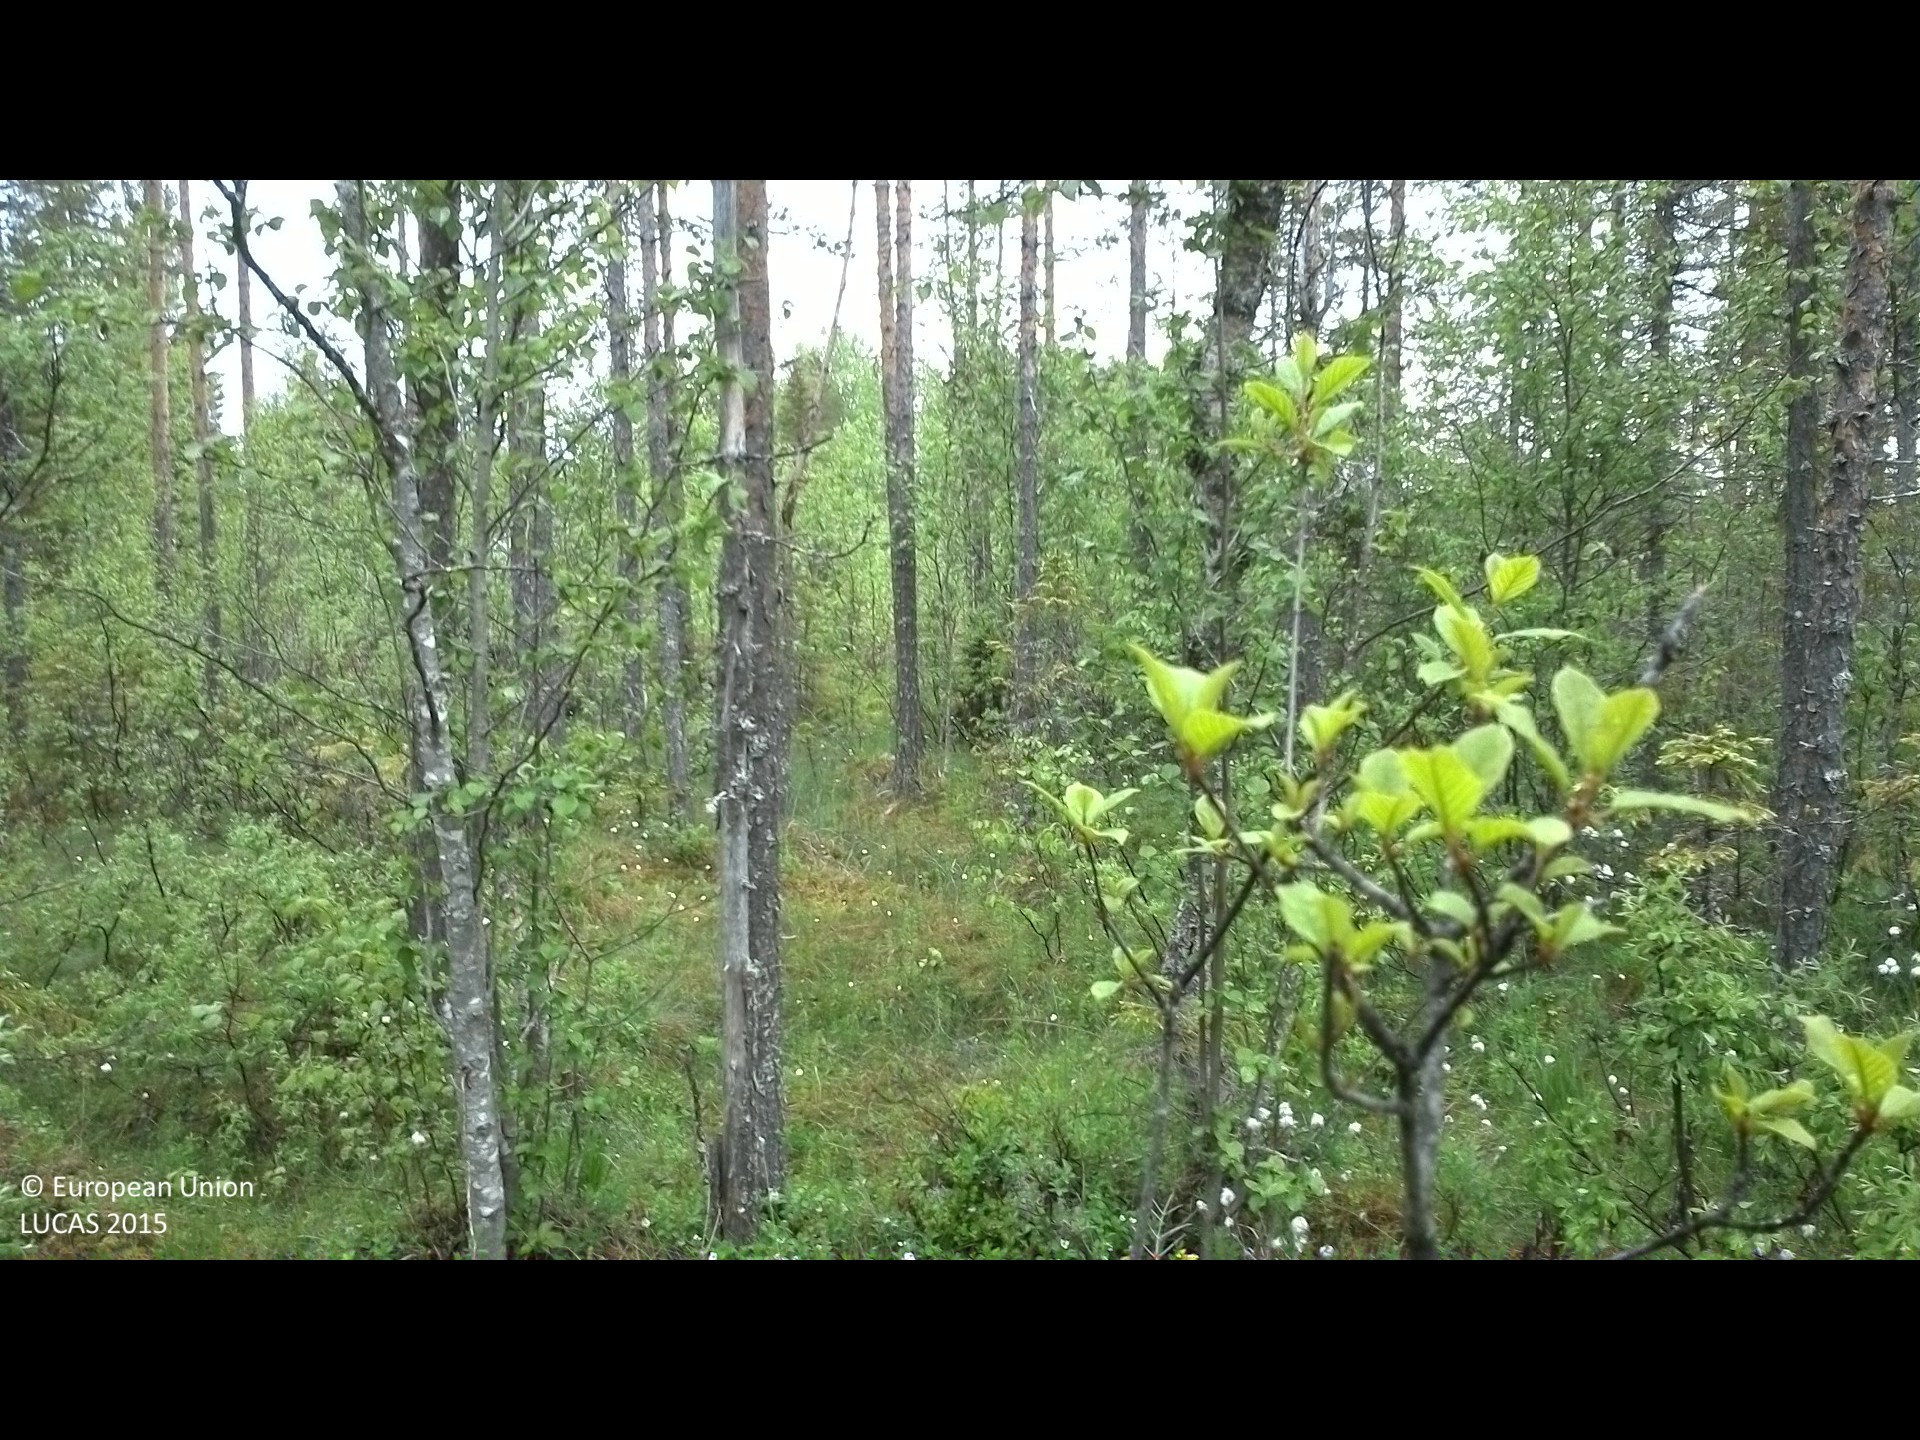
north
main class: Woodland
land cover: Pine dominated mixed woodland
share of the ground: 10 - 25 %
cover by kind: lichens and mosses 50 %, shrubs 25 %, coniferous forest trees 10 %, herbaceous plants 10 %, broadleaved forest trees 5 %
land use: Forestry
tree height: > 5 m
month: June
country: SE
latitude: 61.9186
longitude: 17.1239
